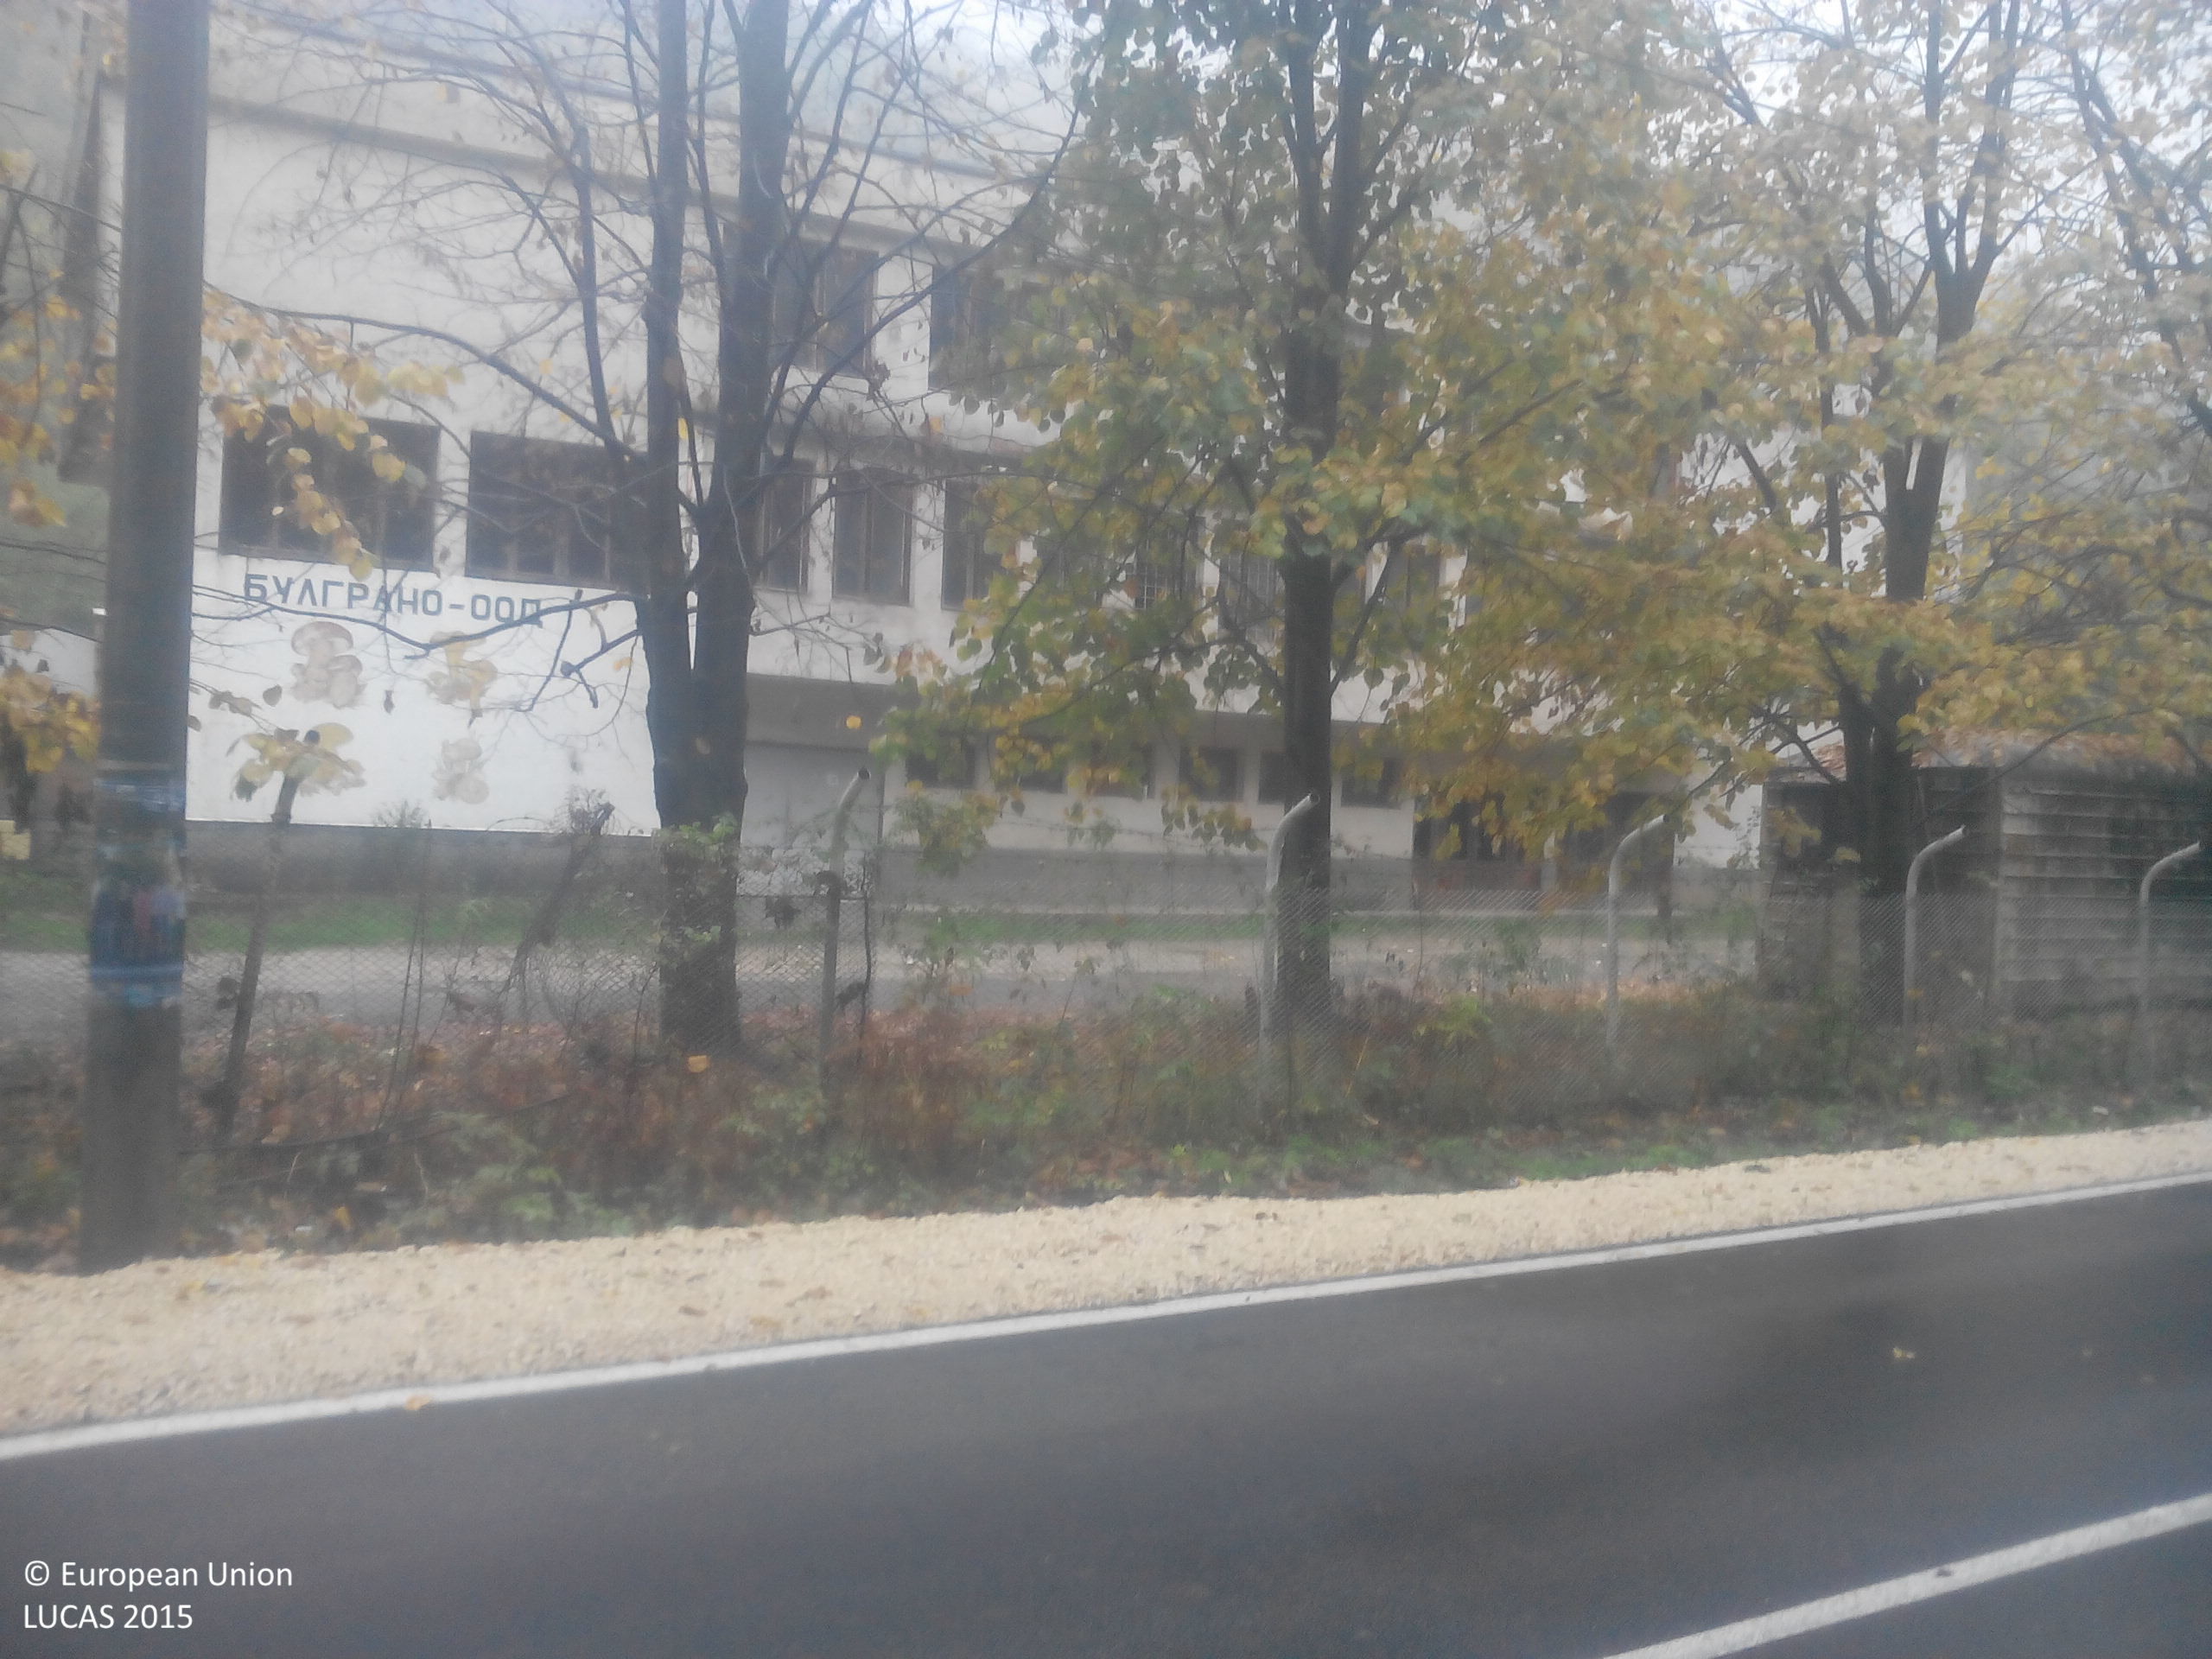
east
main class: Woodland
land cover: Broadleaved woodland
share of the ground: 50 - 75 %
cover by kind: broadleaved forest trees 70 %, herbaceous plants 20 %, shrubs 10 %
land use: Semi-natural and natural areas not in use
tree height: > 5 m
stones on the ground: < 10 %
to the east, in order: Broadleaved woodland; Rivers and streams; Grass margins; Artificial constructions in urban areas; Broadleaved woodland
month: October
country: BG
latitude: 42.9962
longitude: 24.2436
